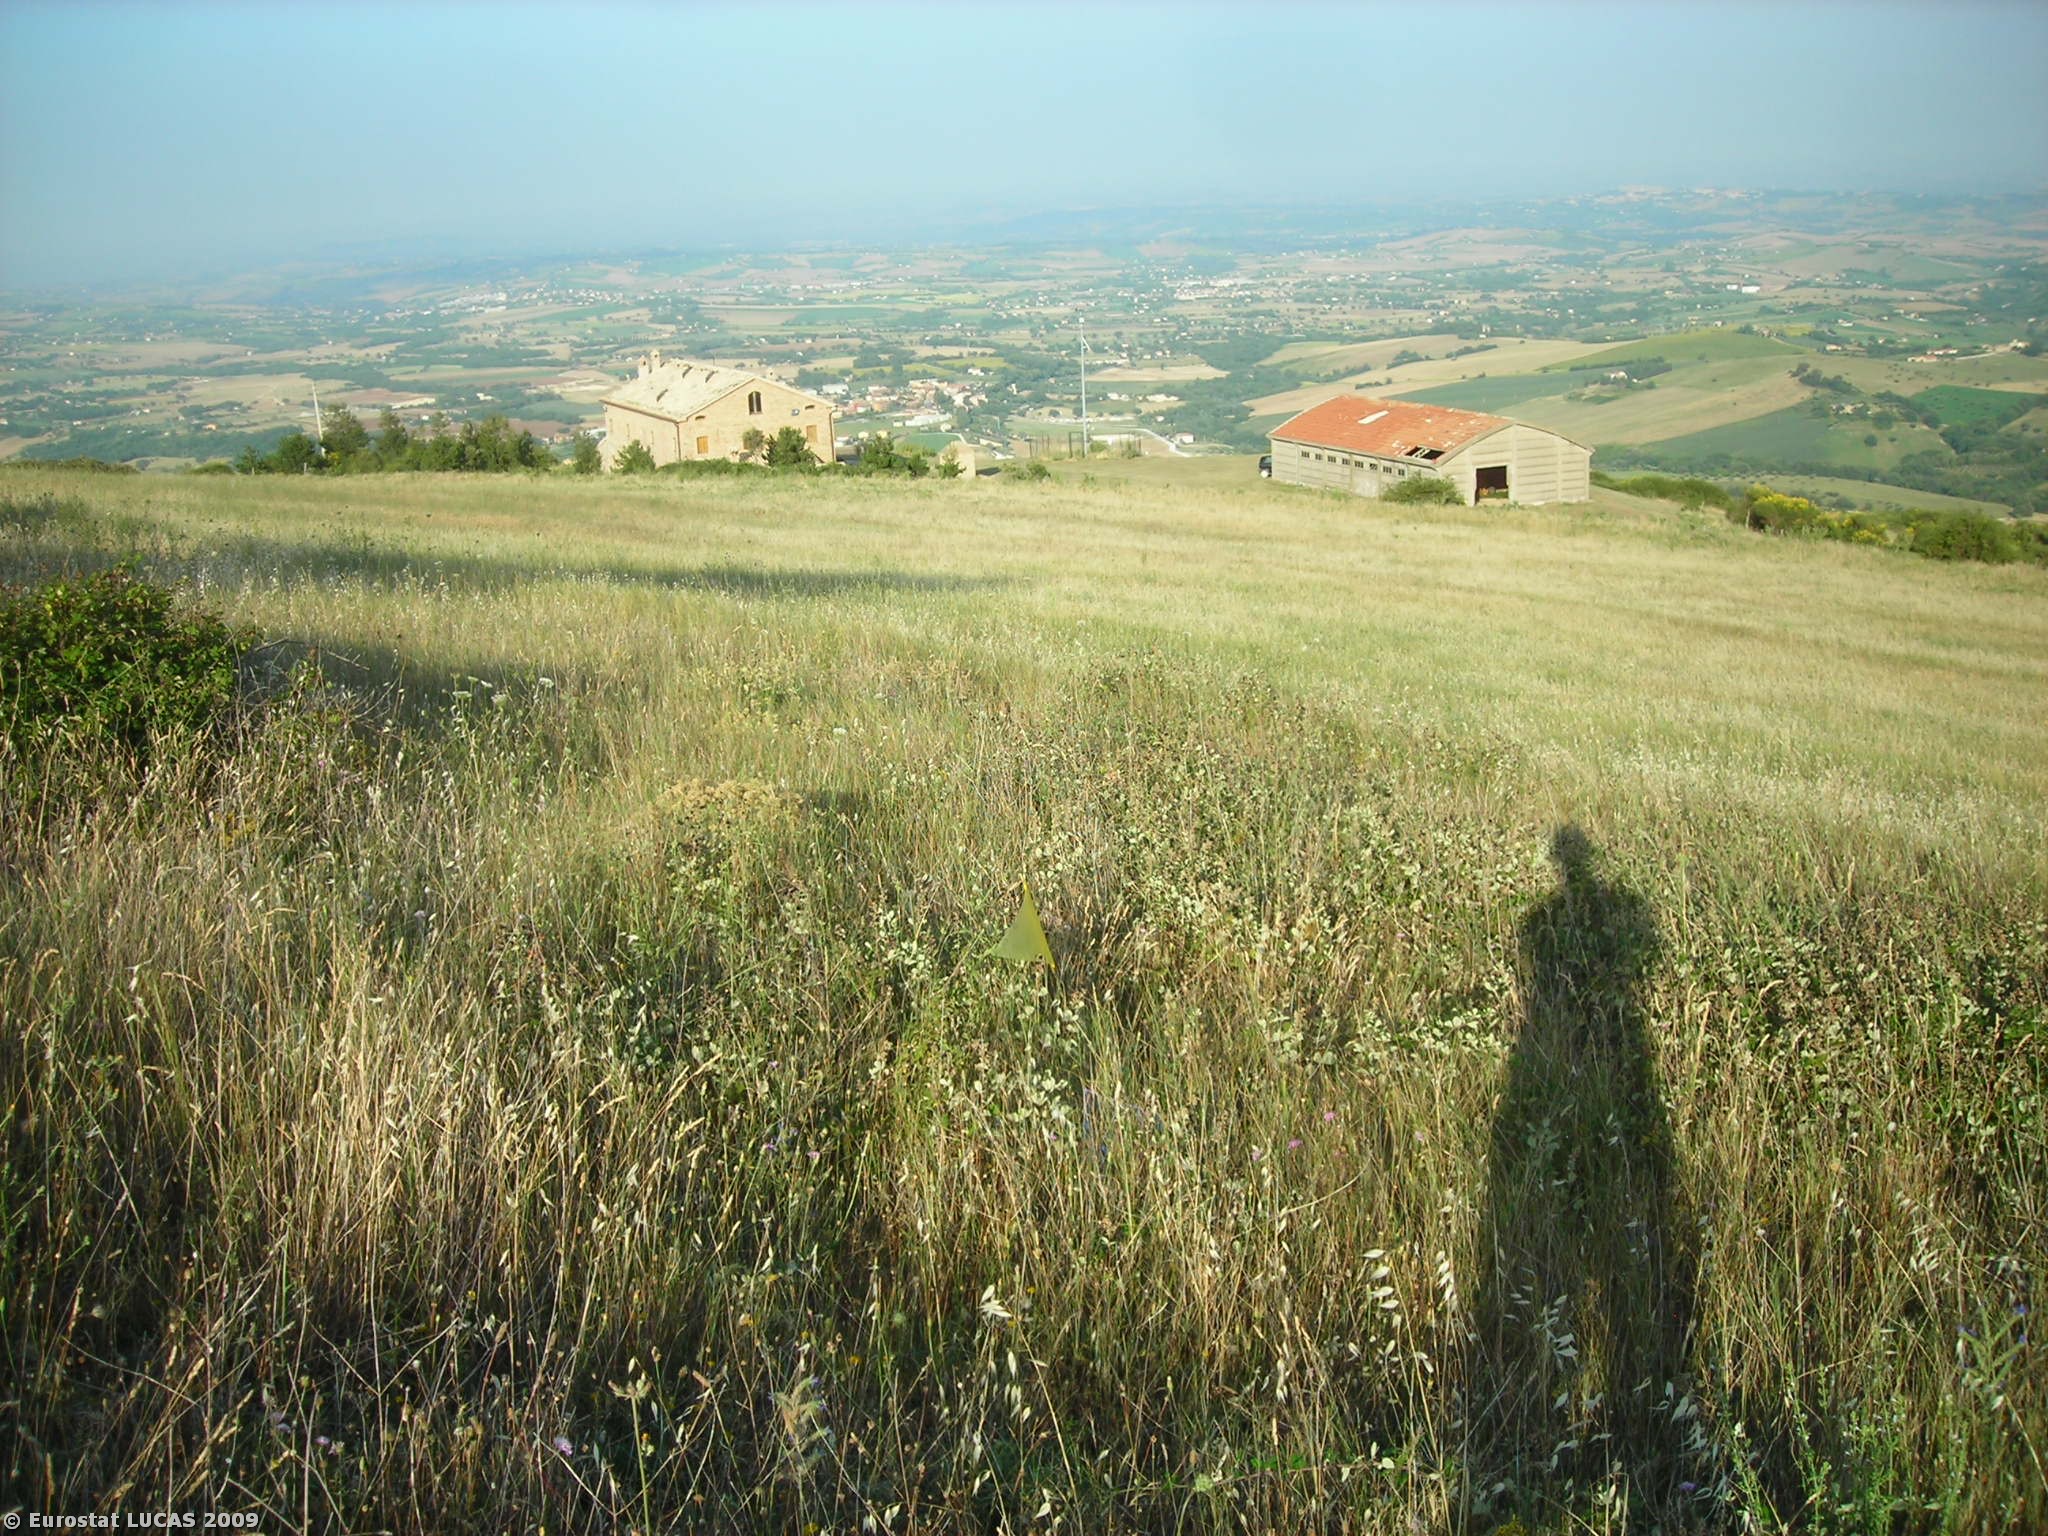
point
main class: Grassland
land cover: Grassland without tree/shrub cover
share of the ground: > 75 %
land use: Agriculture (excluding fallow land and kitchen gardens)
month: July
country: IT
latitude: 43.3432
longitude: 13.2359
